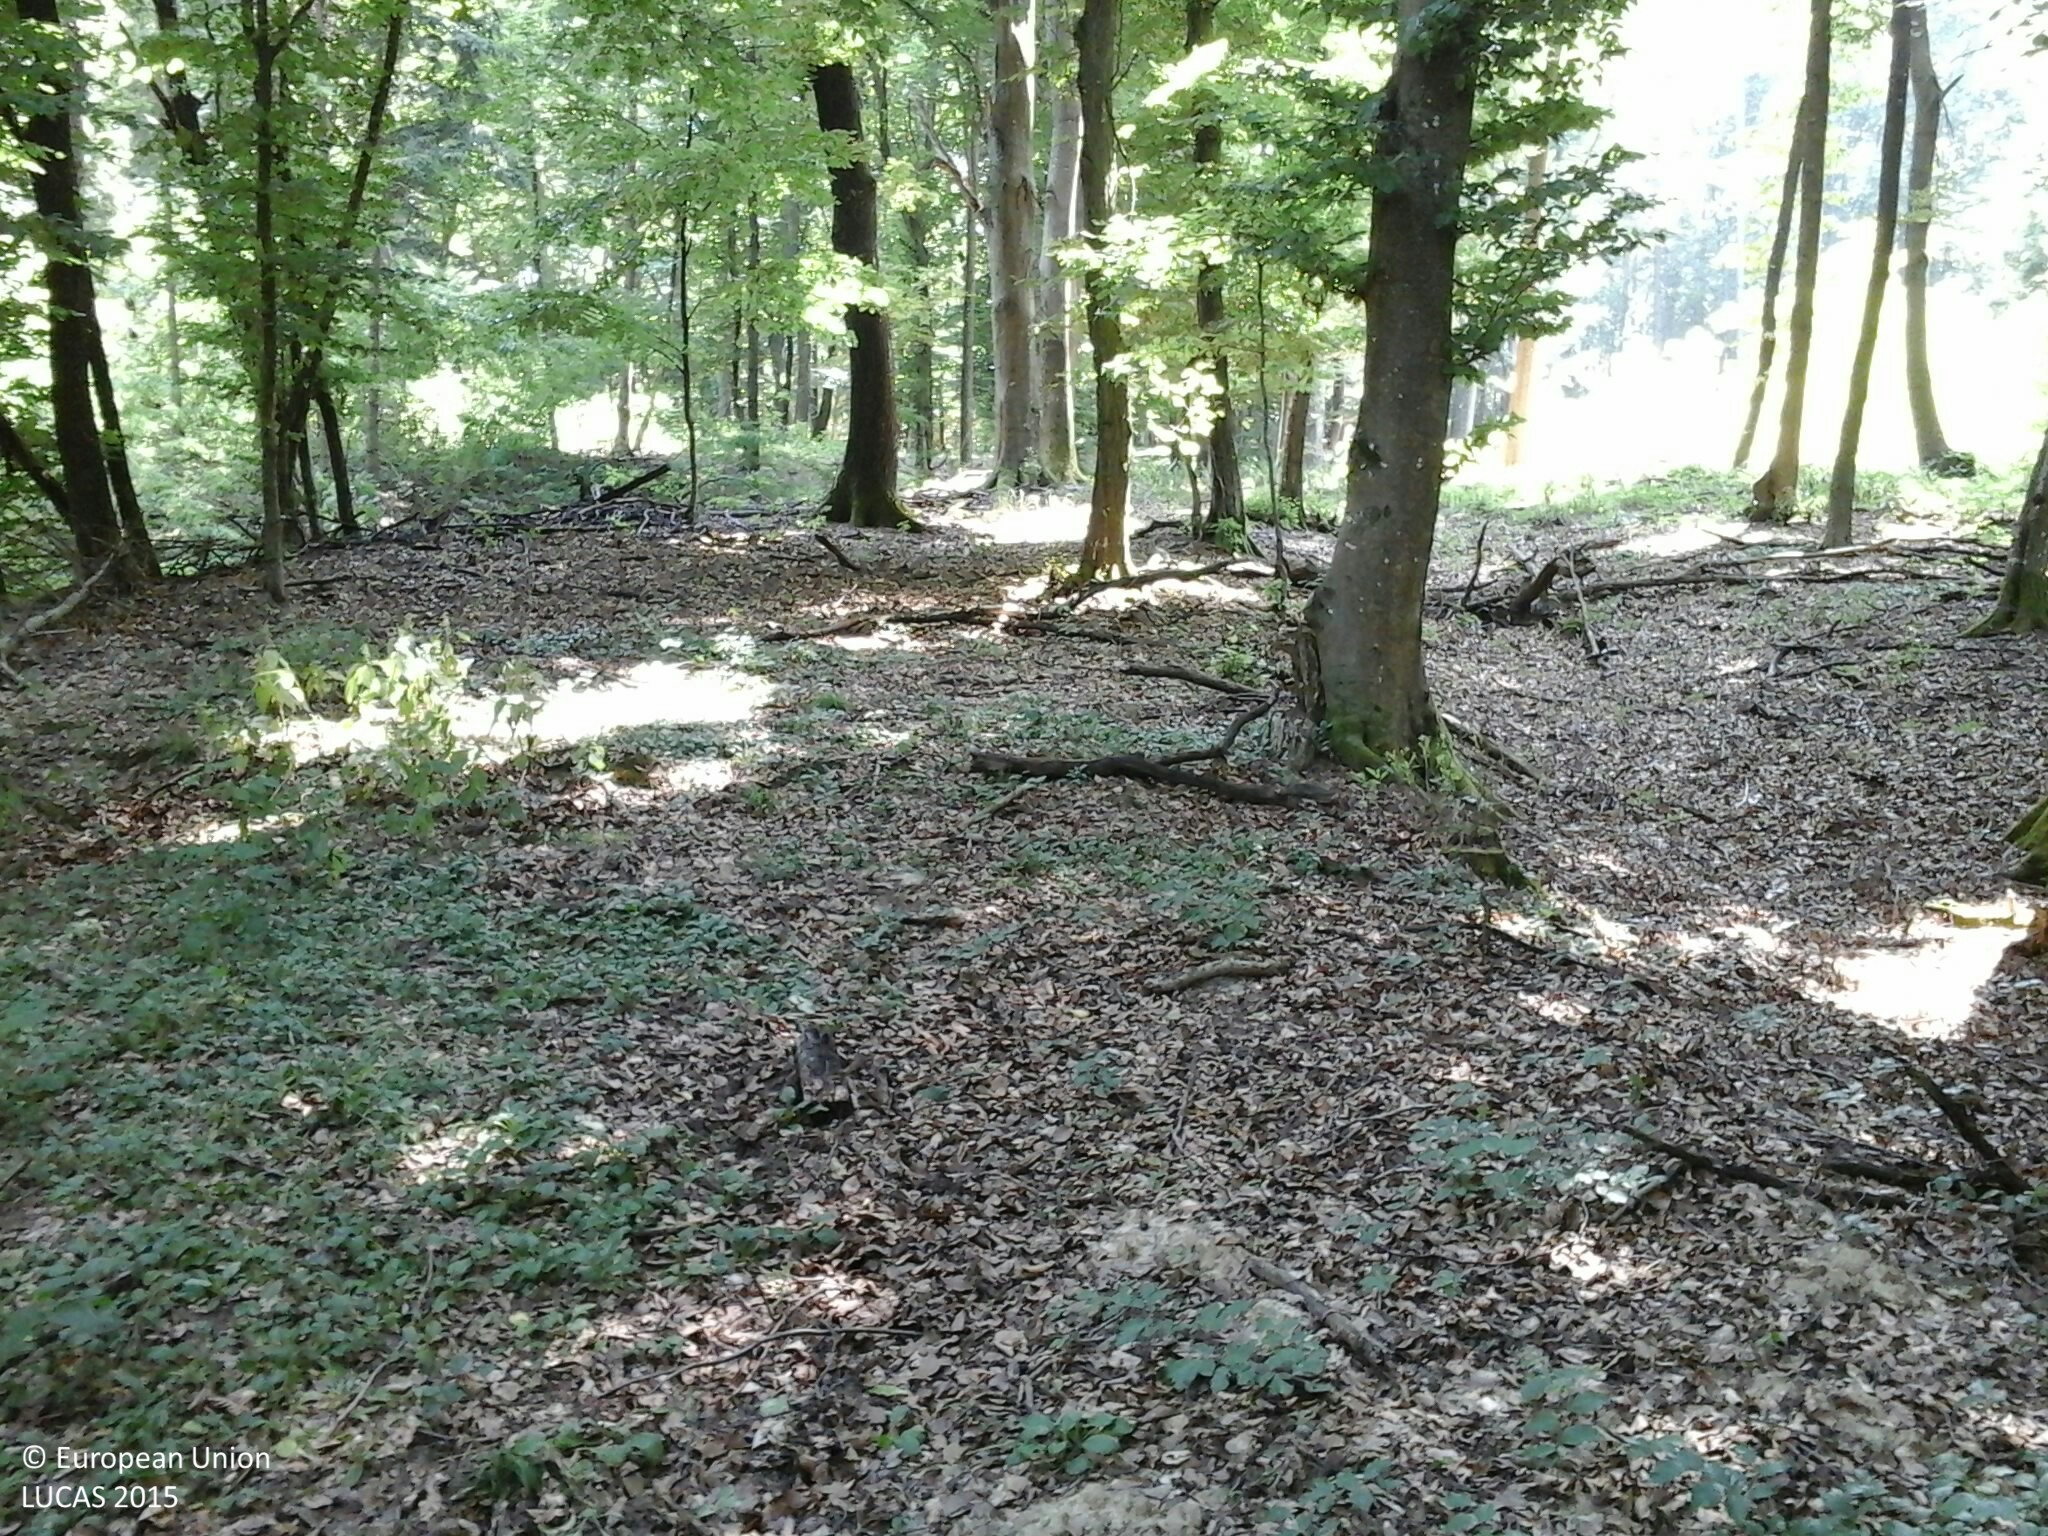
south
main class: Woodland
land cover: Spruce dominated coniferous woodland
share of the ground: > 75 %
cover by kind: coniferous forest trees 90 %, broadleaved forest trees 10 %
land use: Forestry
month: July
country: HU
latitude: 46.9347
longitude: 16.4252
